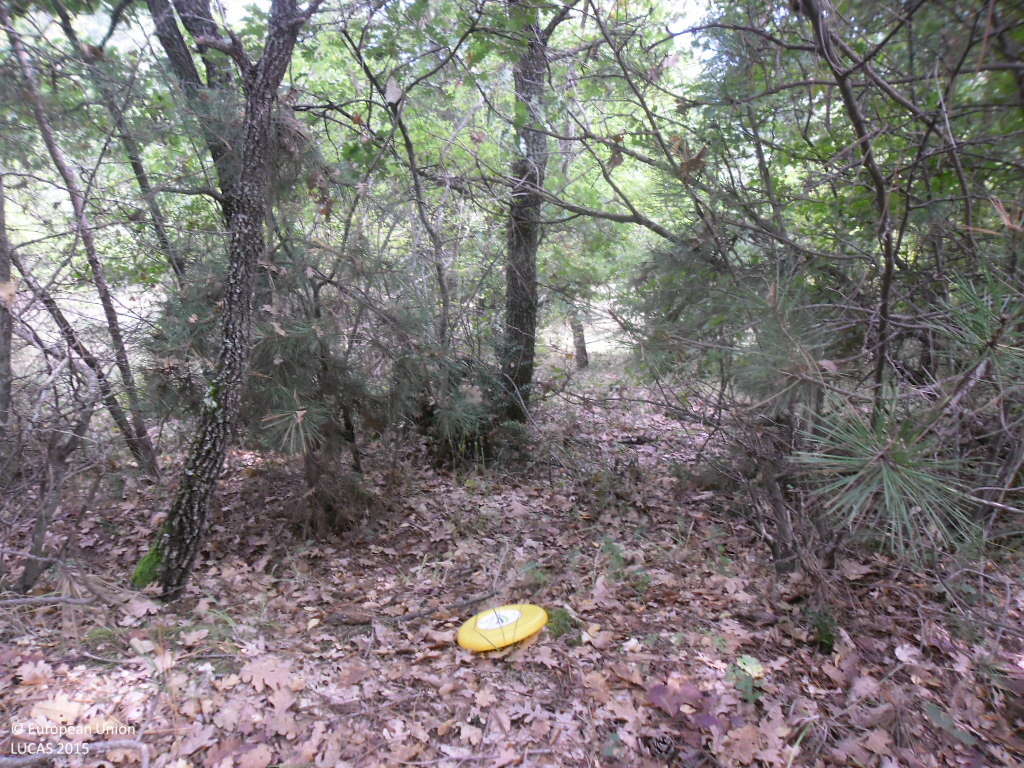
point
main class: Woodland
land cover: Other mixed woodland
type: hemiboreal forest and nemoral coniferous forest and mixed broadleaved-coniferous forest
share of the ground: > 75 %
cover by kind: coniferous forest trees 75 %, broadleaved forest trees 25 %
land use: Forestry
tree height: > 5 m
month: September
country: BG
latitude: 41.4014
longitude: 23.0671
